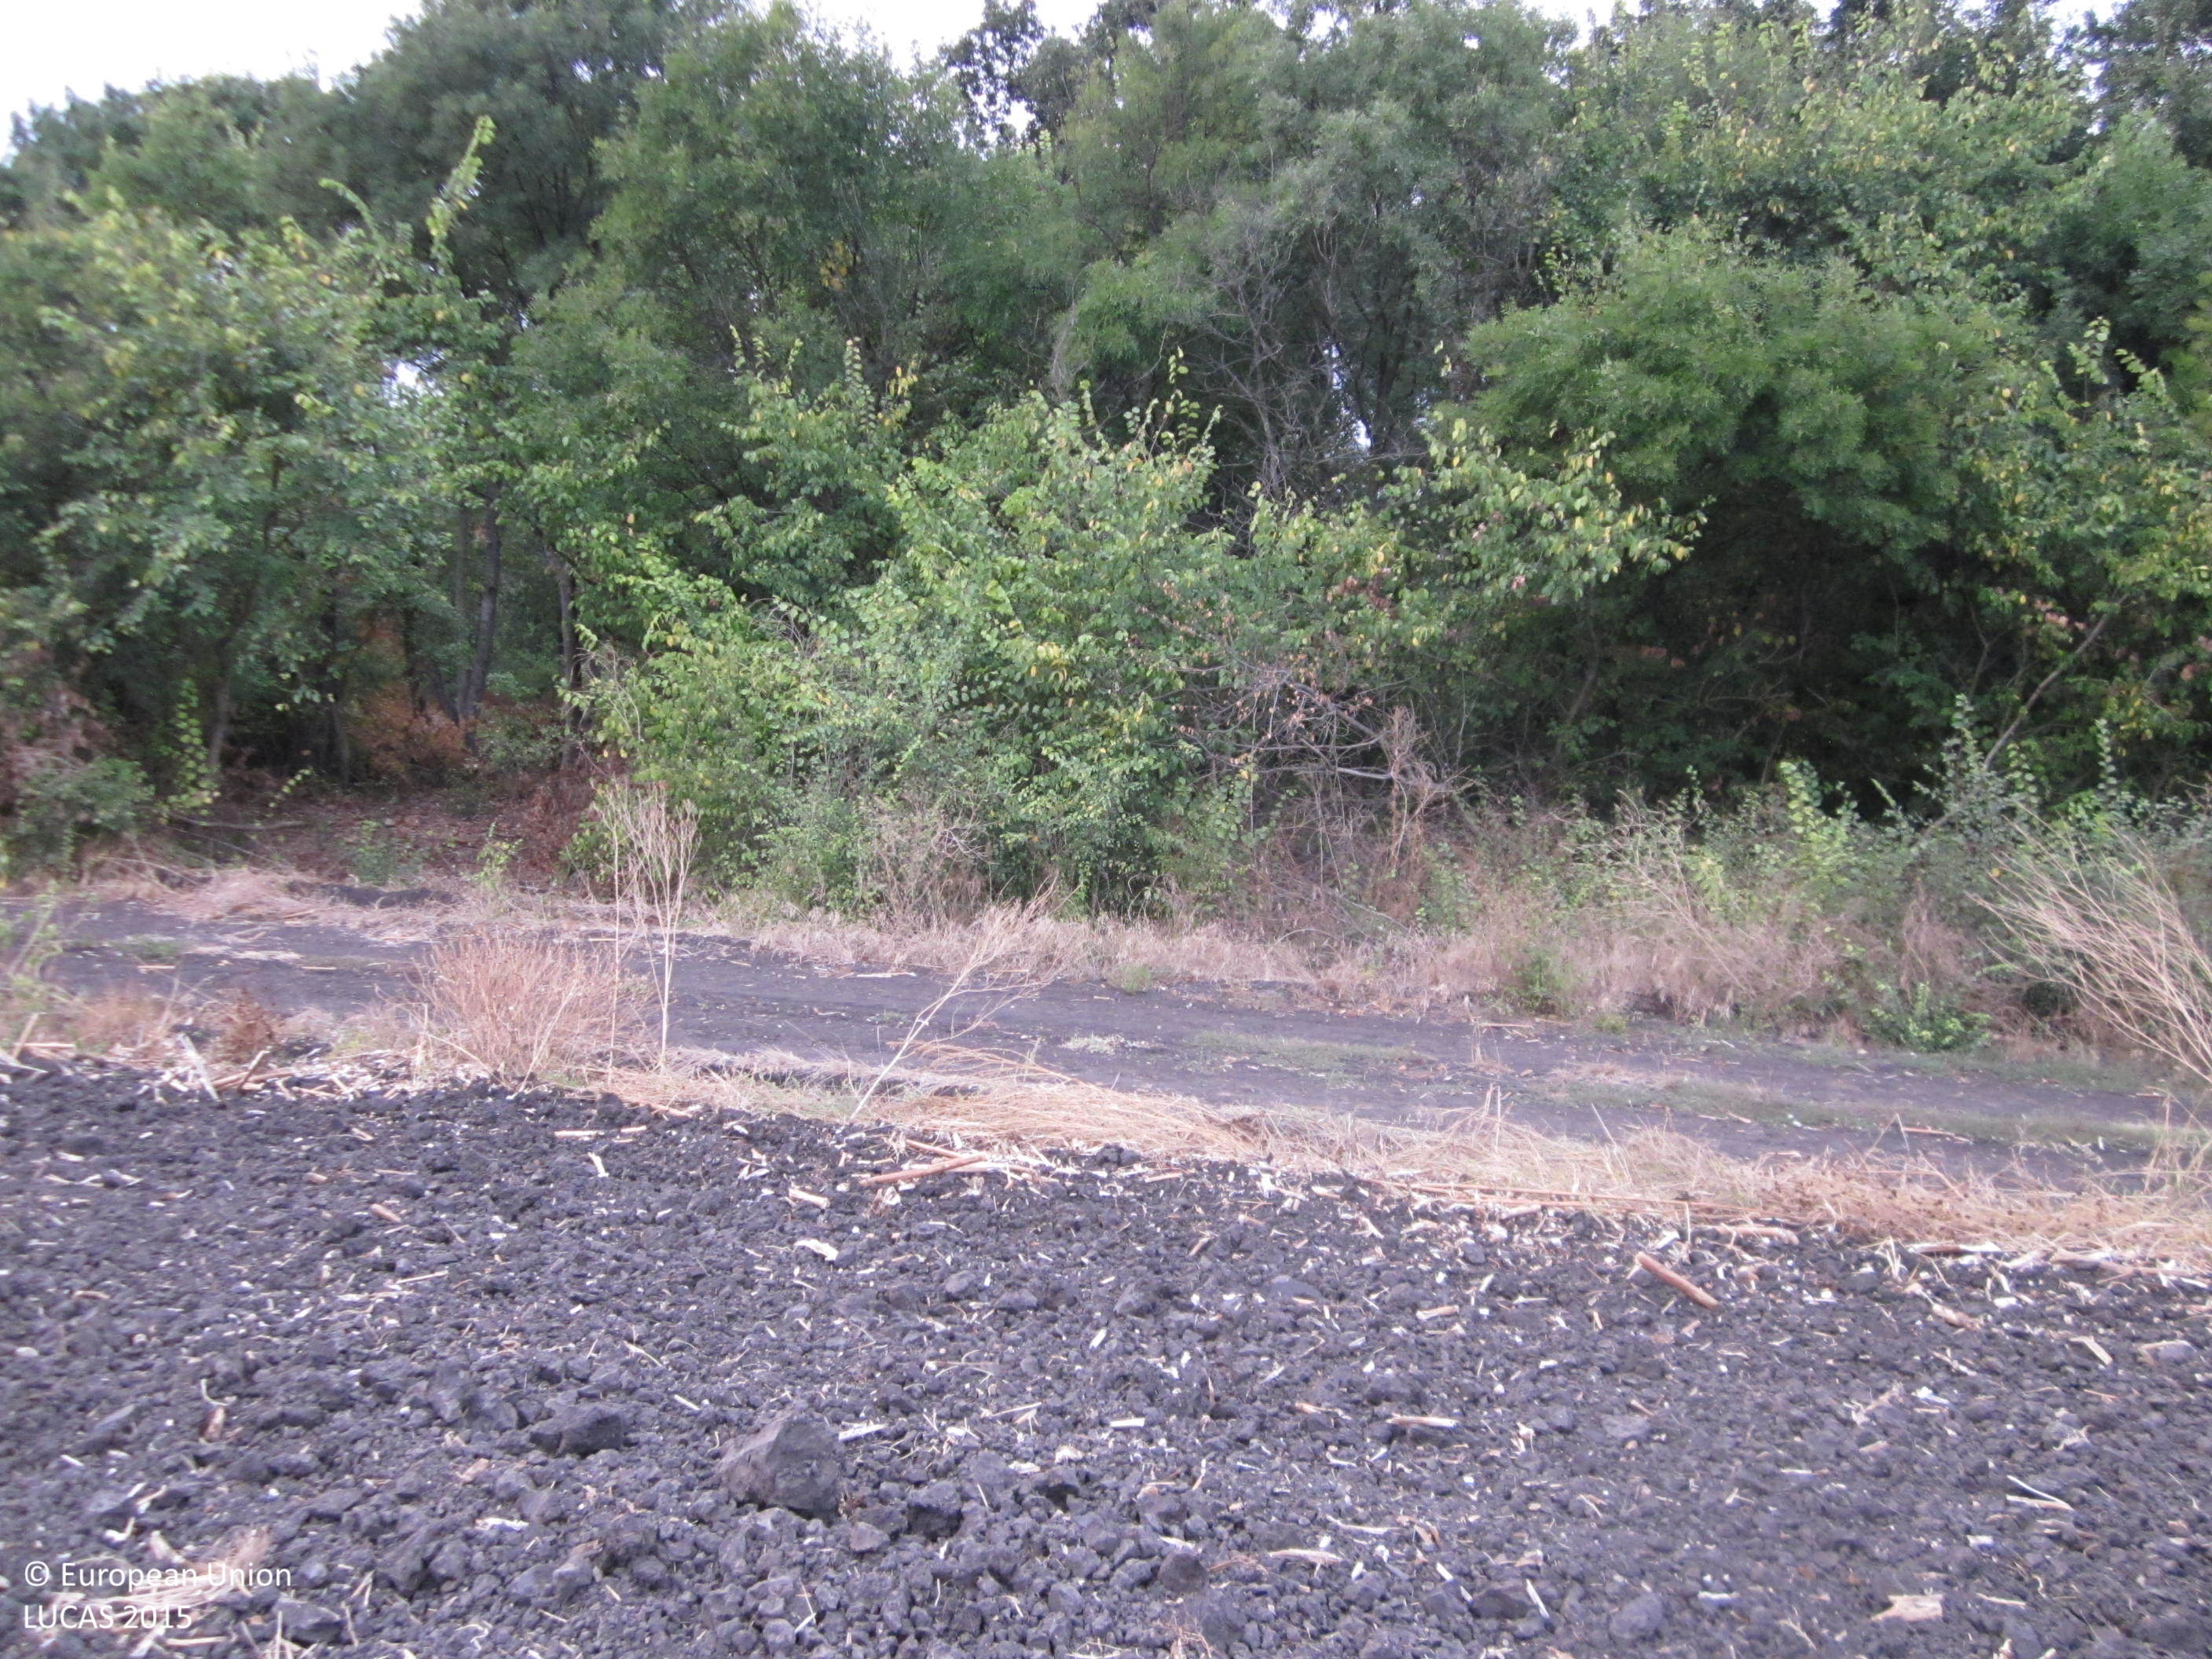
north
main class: Cropland
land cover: Sunflower
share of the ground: < 10 %
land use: Agriculture (excluding fallow land and kitchen gardens)
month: September
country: BG
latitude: 42.4208
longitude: 27.2085
